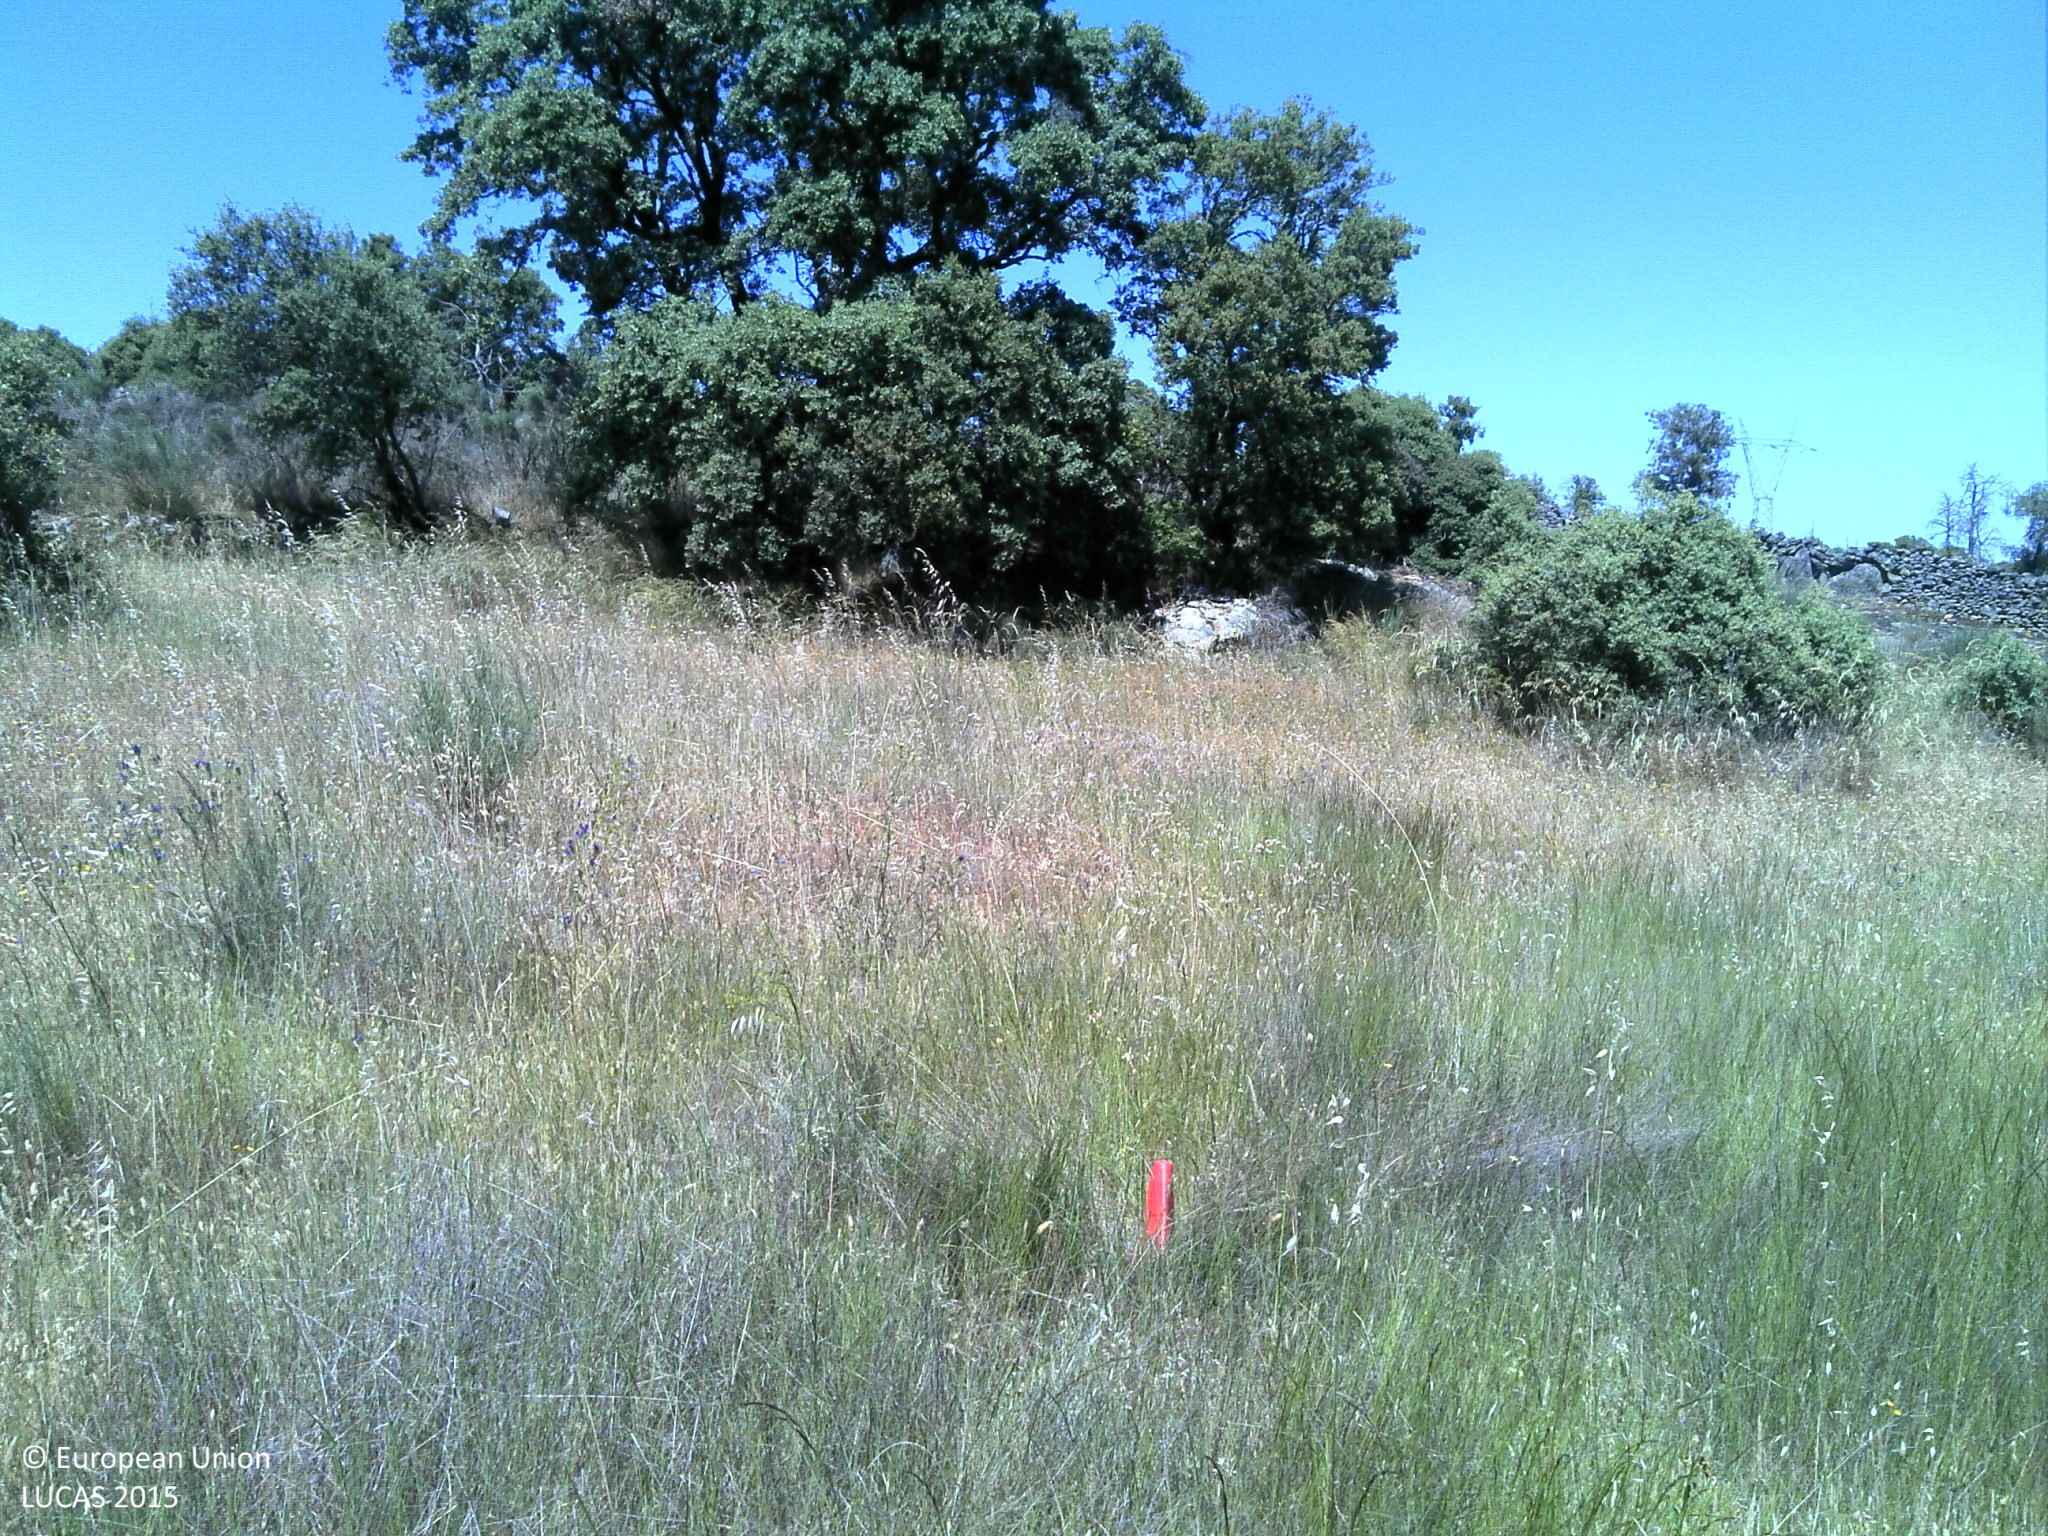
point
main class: Grassland
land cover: Grassland with sparse tree/shrub cover
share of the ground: > 75 %
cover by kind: herbaceous plants 80 %, unconsolidated bare surface 15 %, broadleaved forest trees 5 %
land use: Agriculture (excluding fallow land and kitchen gardens)
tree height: > 5 m
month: May
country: PT
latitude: 41.4276
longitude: -6.3360
